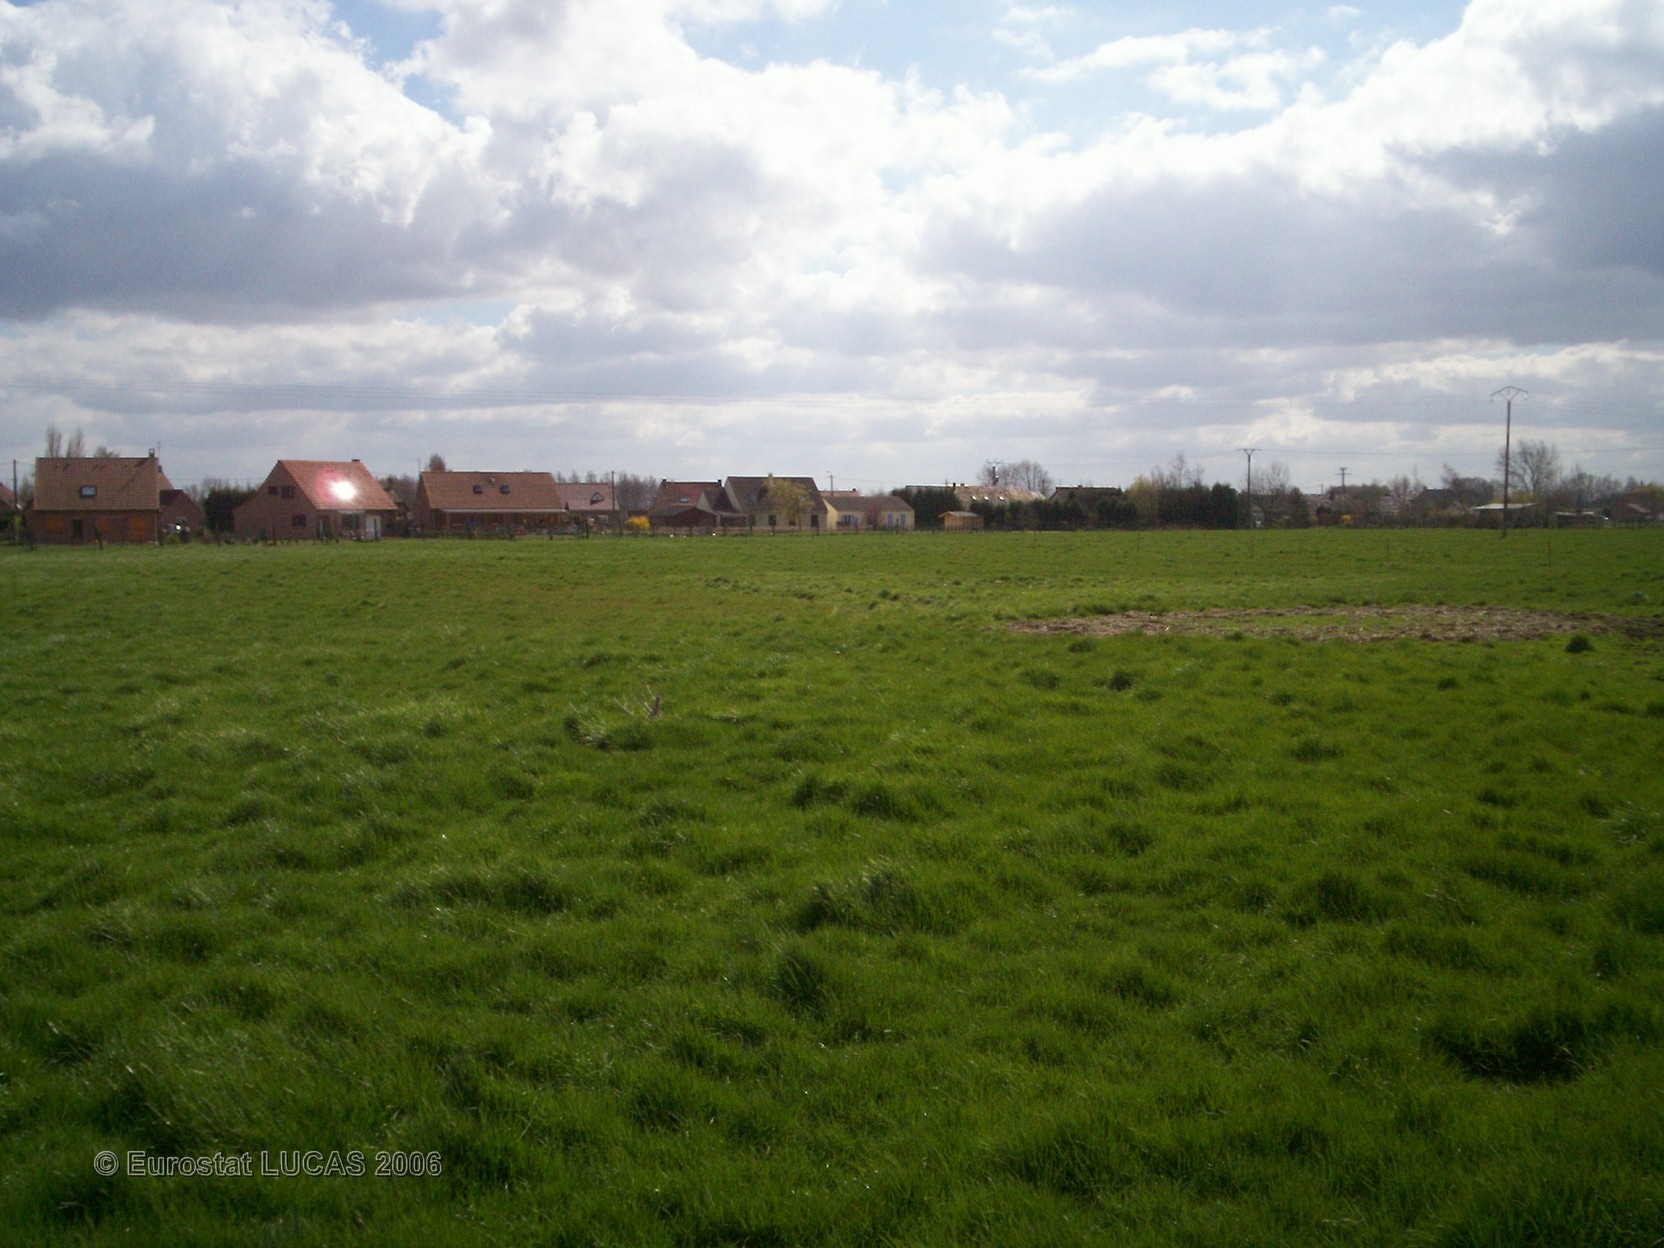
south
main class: Grassland
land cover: Grassland without tree/shrub cover
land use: Agriculture (excluding fallow land and kitchen gardens)
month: April
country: FR
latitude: 50.5937
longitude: 2.5998
